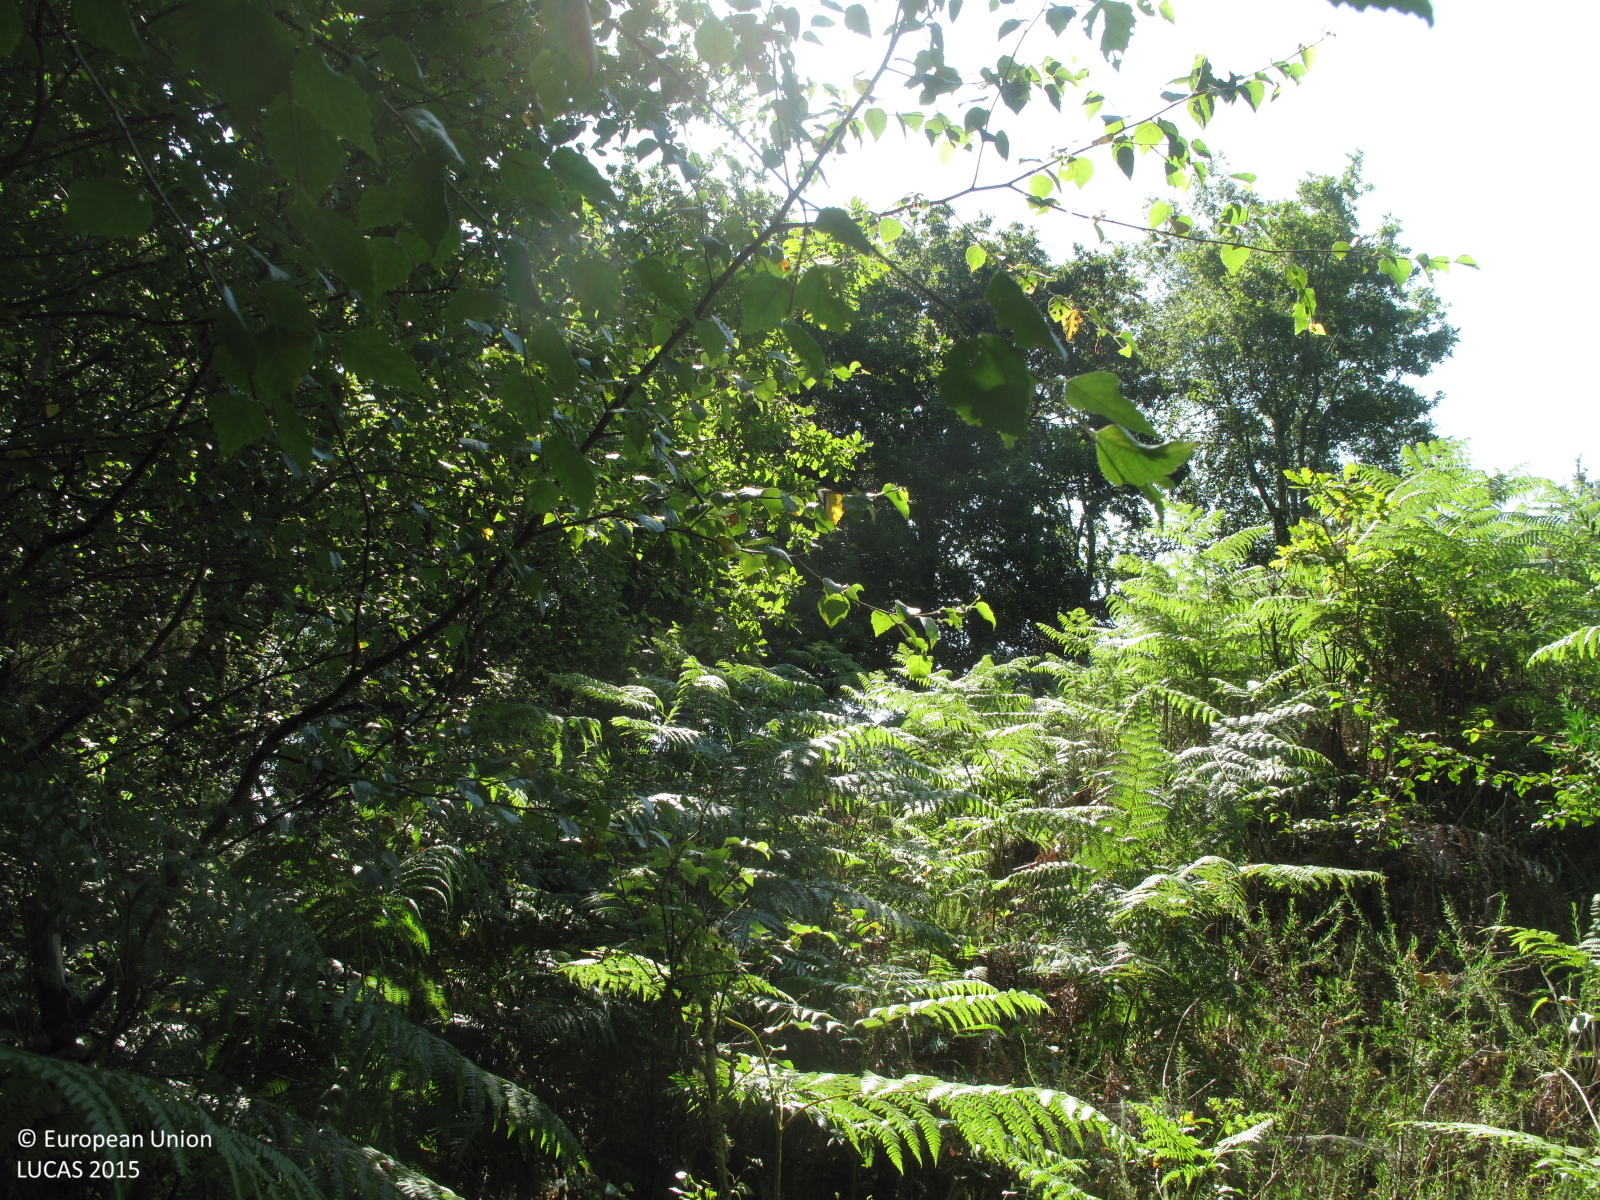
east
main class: Woodland
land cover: Broadleaved woodland
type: acidophilous oak and oak-birch forest
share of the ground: 50 - 75 %
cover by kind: broadleaved forest trees 60 %, shrubs 30 %, herbaceous plants 10 %
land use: Semi-natural and natural areas not in use
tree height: > 5 m
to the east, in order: Broadleaved woodland; Shrubland with sparse tree cover; Rock outcrops; Shrubland with sparse tree cover; Fences; Grassland without tree/shrub cover
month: July
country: ES
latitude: 43.3341
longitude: -7.9900
